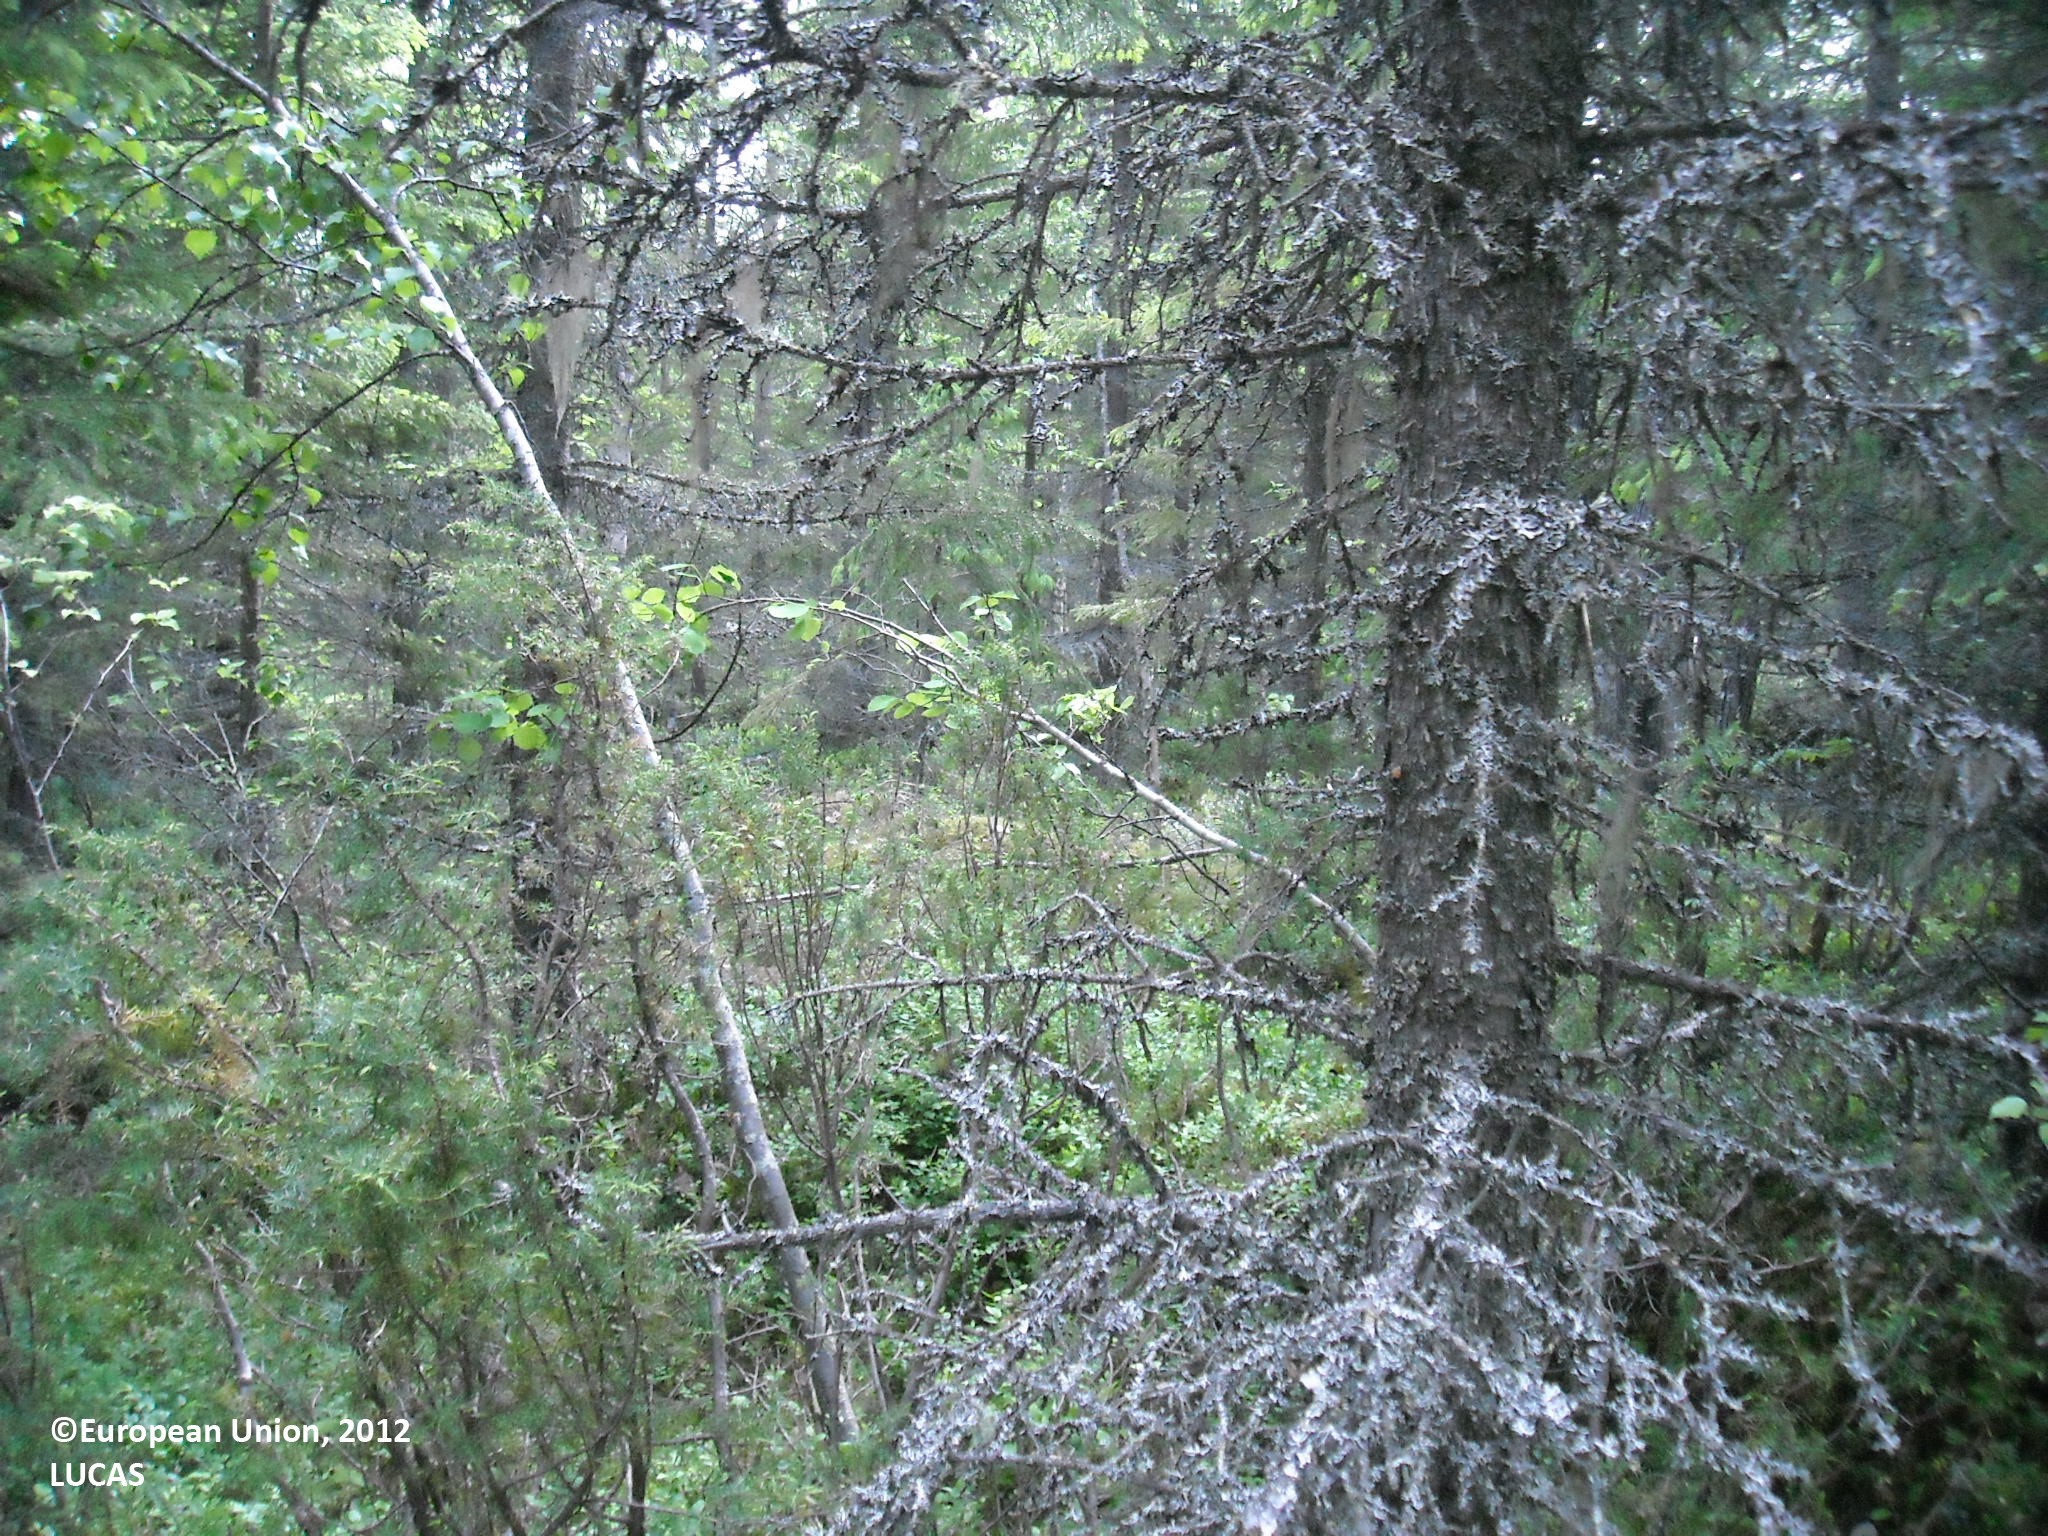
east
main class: Woodland
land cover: Spruce dominated coniferous woodland
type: boreal forest
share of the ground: > 75 %
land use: Forestry
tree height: > 5 m
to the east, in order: Spruce dominated coniferous woodland; Spruce dominated mixed woodland; Ditches and canals; Grass margins; Paved roads, cycling and walking lanes; Grass margins; Ditches and canals; Spruce dominated mixed woodland
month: June
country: FI
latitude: 64.8067
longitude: 27.8572
